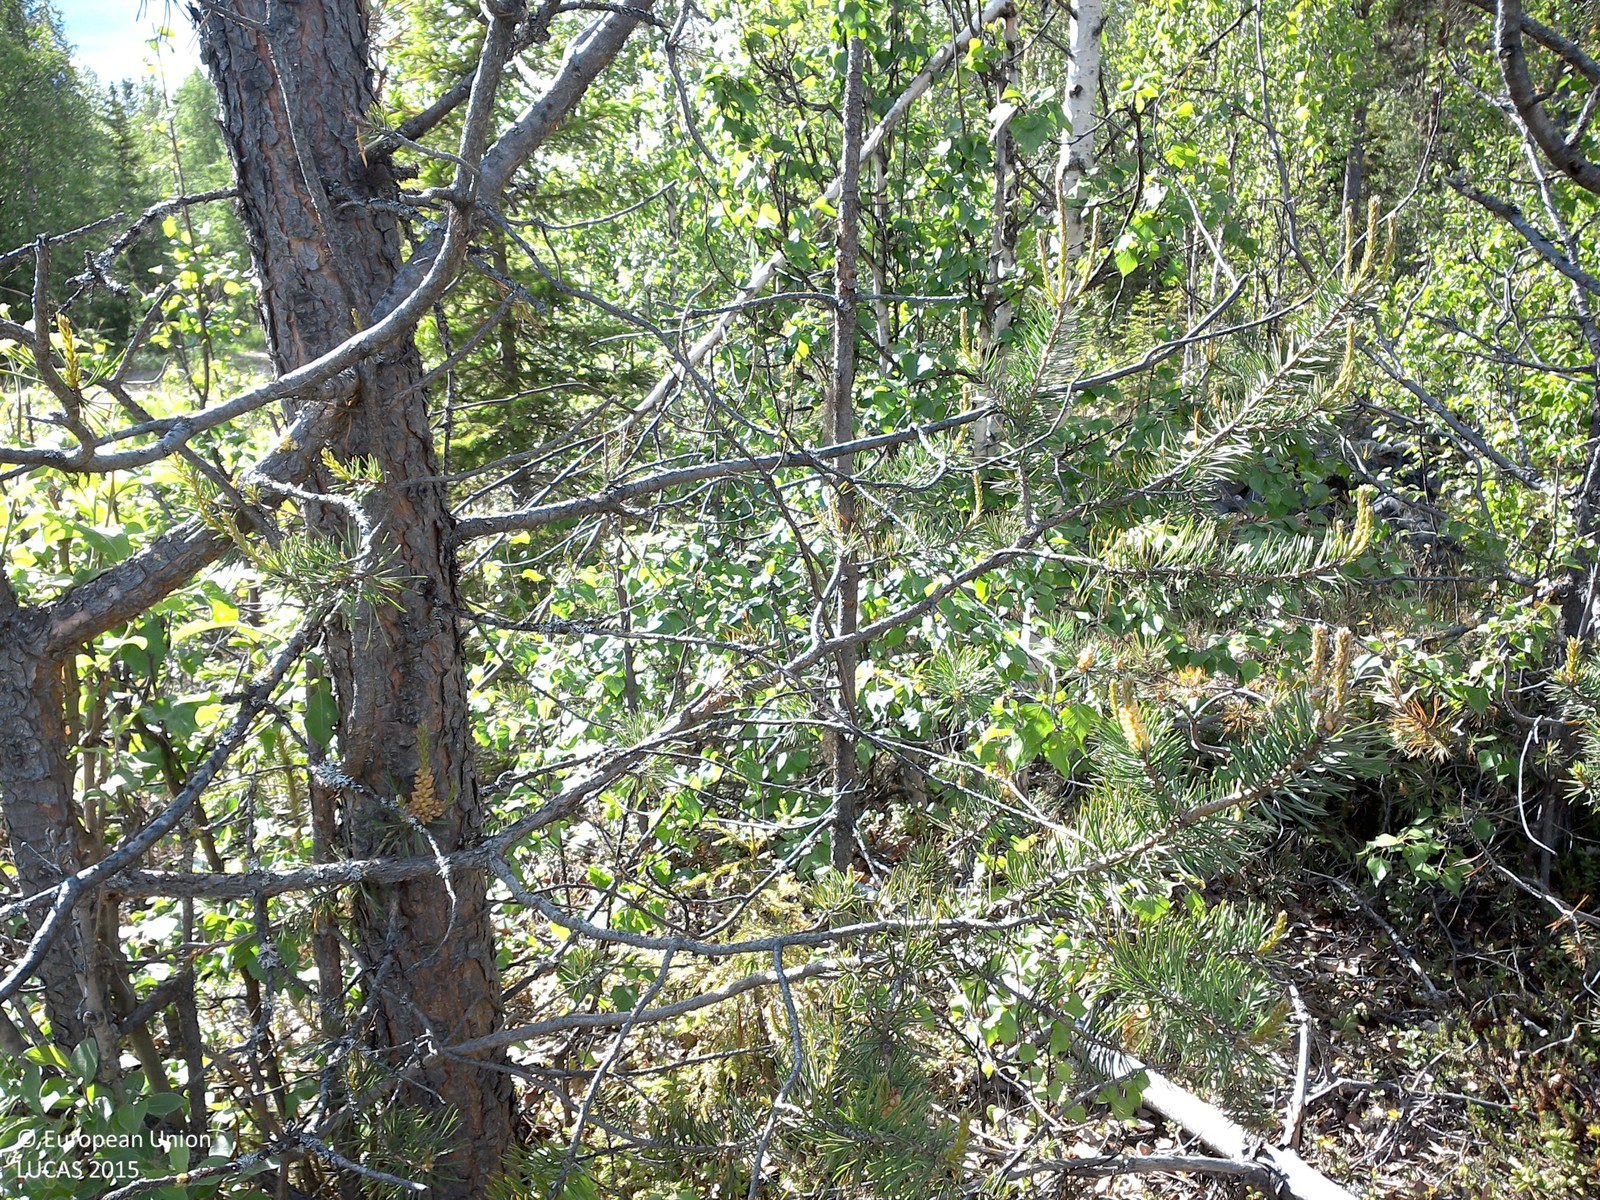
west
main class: Woodland
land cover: Pine dominated mixed woodland
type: boreal forest
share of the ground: 25 - 50 %
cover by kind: shrubs 65 %, coniferous forest trees 15 %, broadleaved forest trees 10 %, lichens and mosses 5 %, unconsolidated bare surface 5 %
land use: Forestry
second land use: Amenities, museums, leisure
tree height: > 5 m
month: June
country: SE
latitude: 66.6308
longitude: 22.8287
